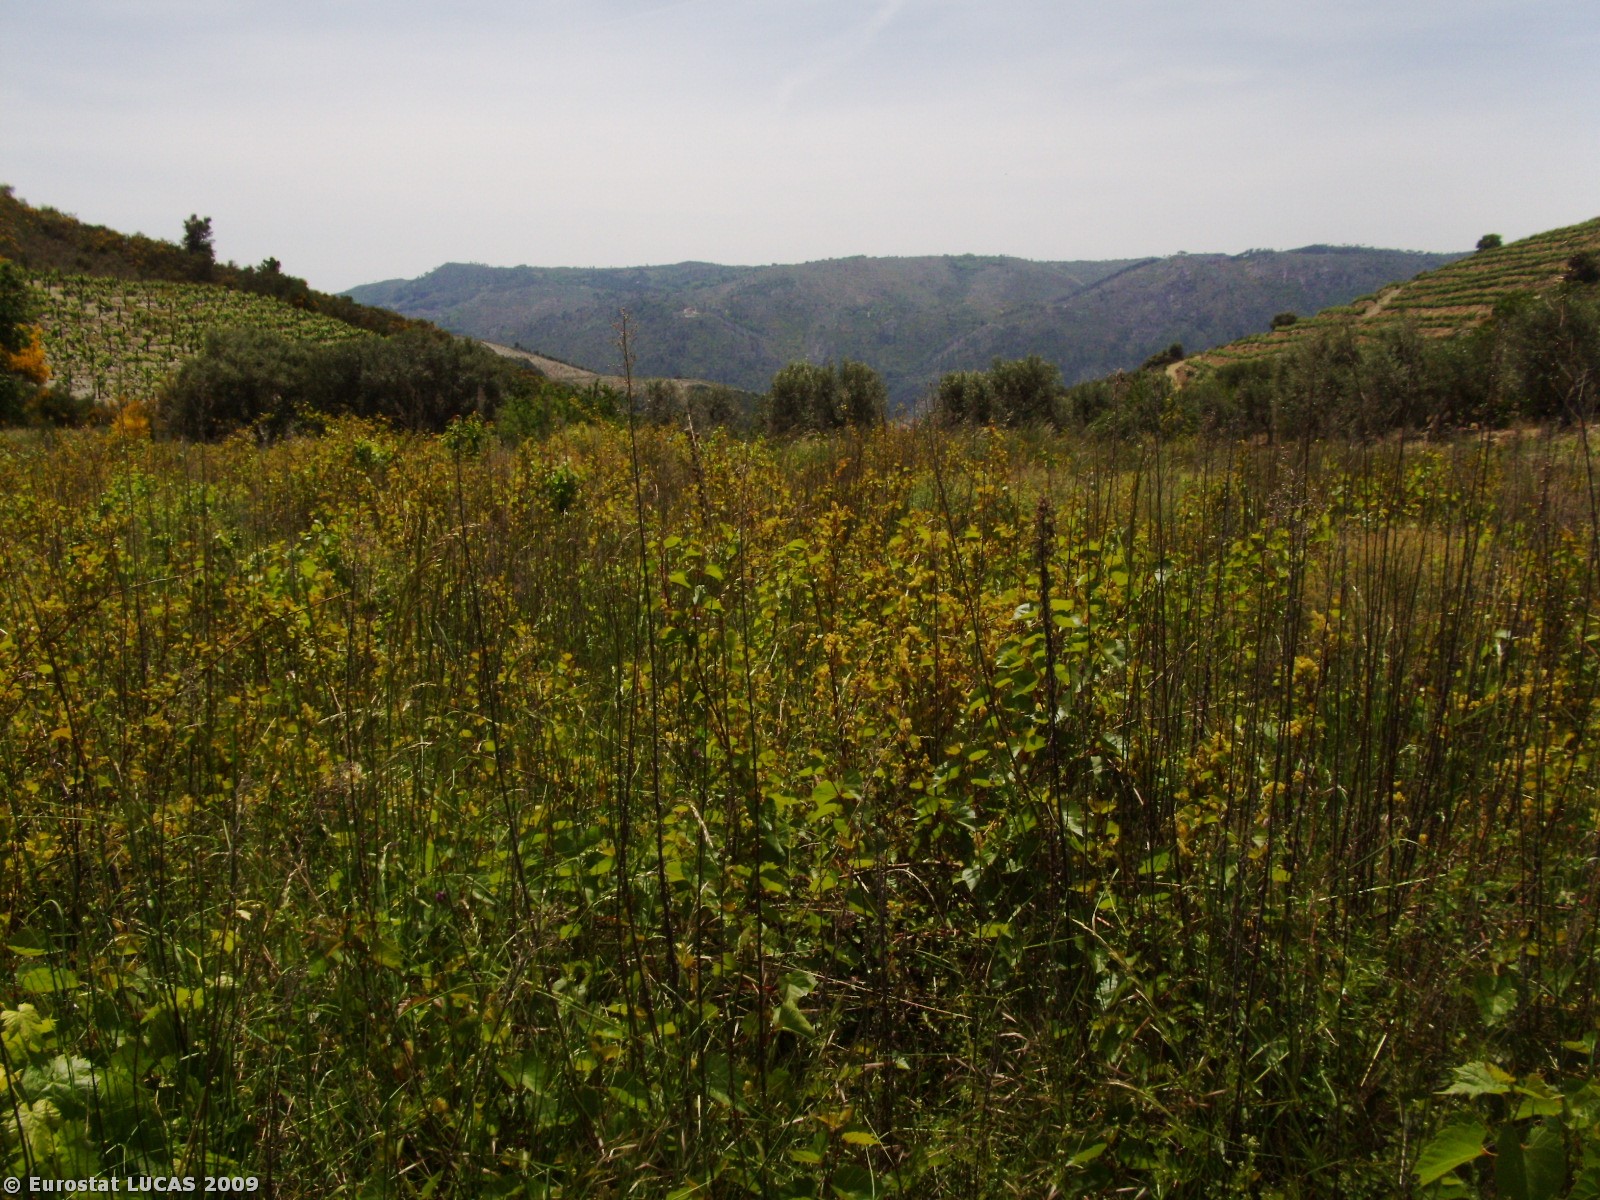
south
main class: Shrubland
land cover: Shrubland without tree cover
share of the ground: > 75 %
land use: Fallow land
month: May
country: PT
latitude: 41.1169
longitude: -7.4971
